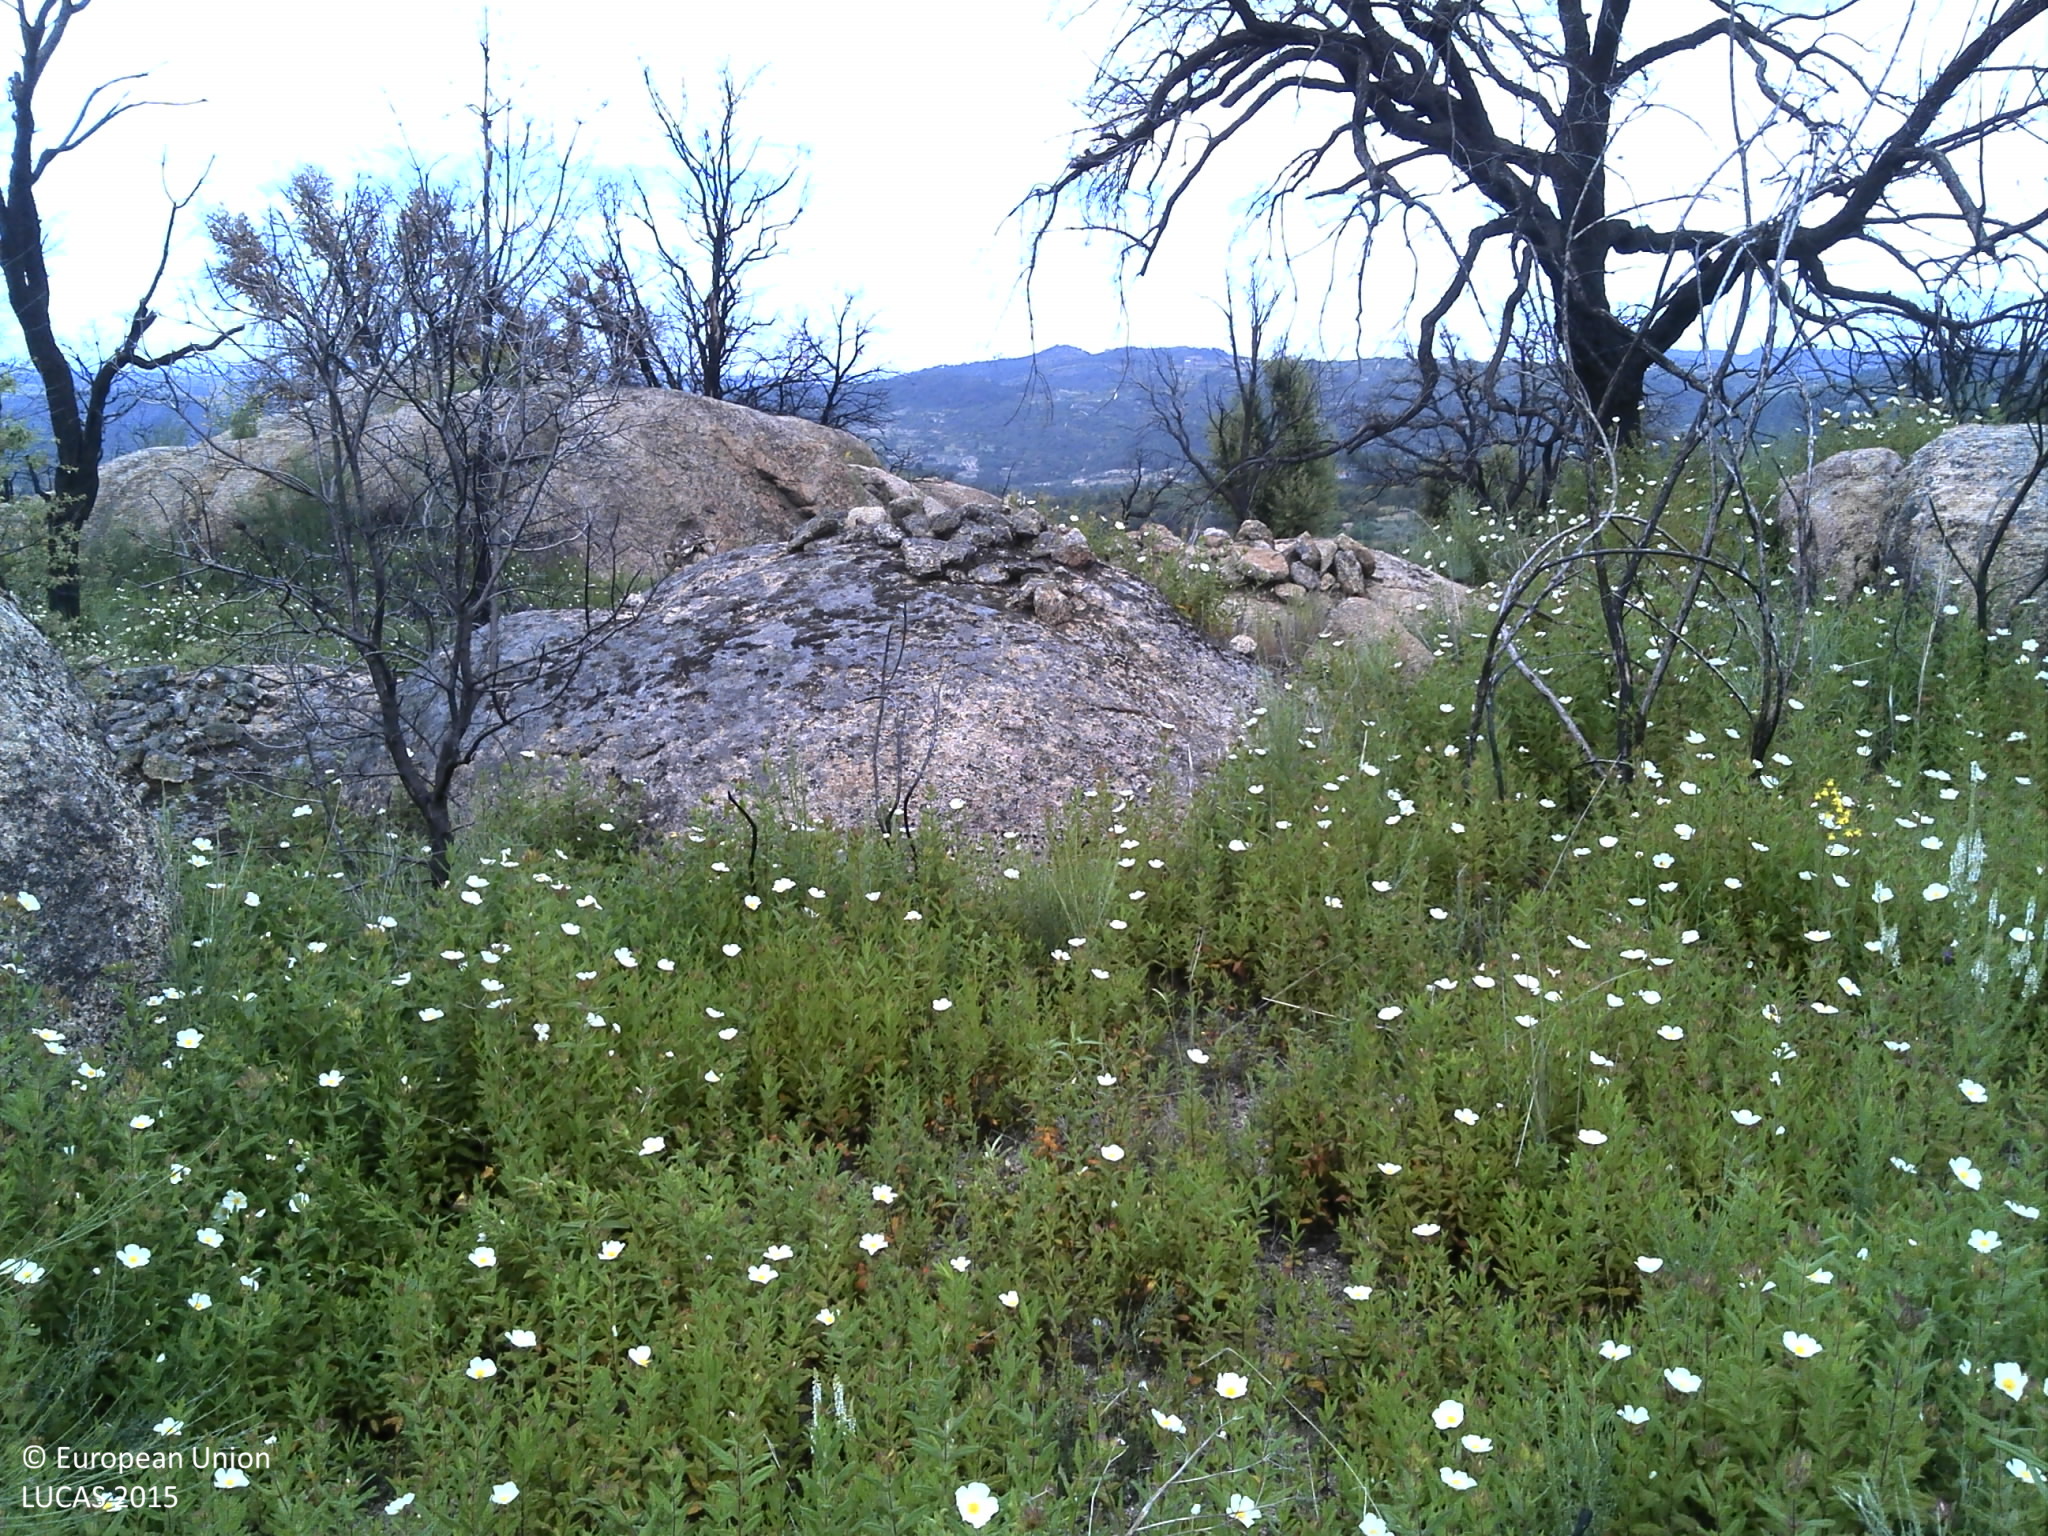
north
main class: Shrubland
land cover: Shrubland with sparse tree cover
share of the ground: 50 - 75 %
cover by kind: shrubs 50 %, consolidated bare surface 45 %, broadleaved forest trees 5 %
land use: Forestry
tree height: < 5 m
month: May
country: PT
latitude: 41.6677
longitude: -7.0902
